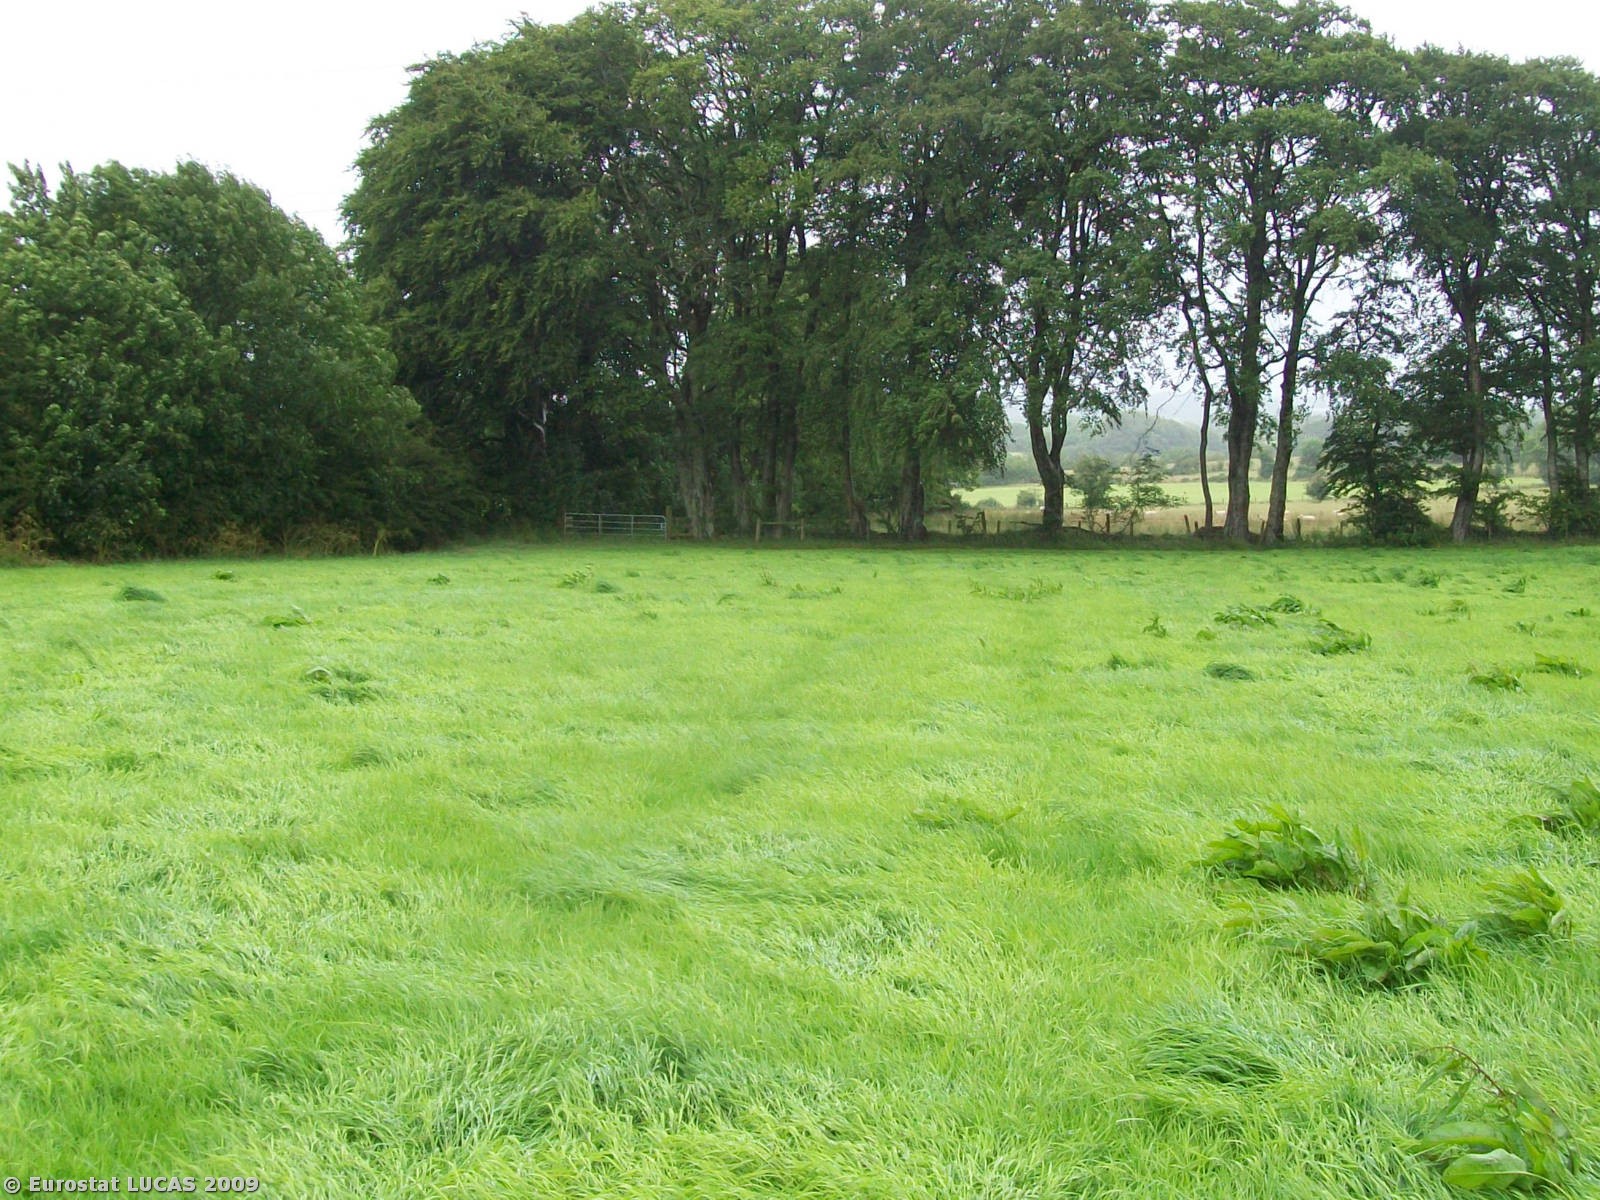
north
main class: Grassland
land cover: Grassland without tree/shrub cover
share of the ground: > 75 %
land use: Agriculture (excluding fallow land and kitchen gardens)
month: July
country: GB
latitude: 54.8009
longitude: -6.1834
